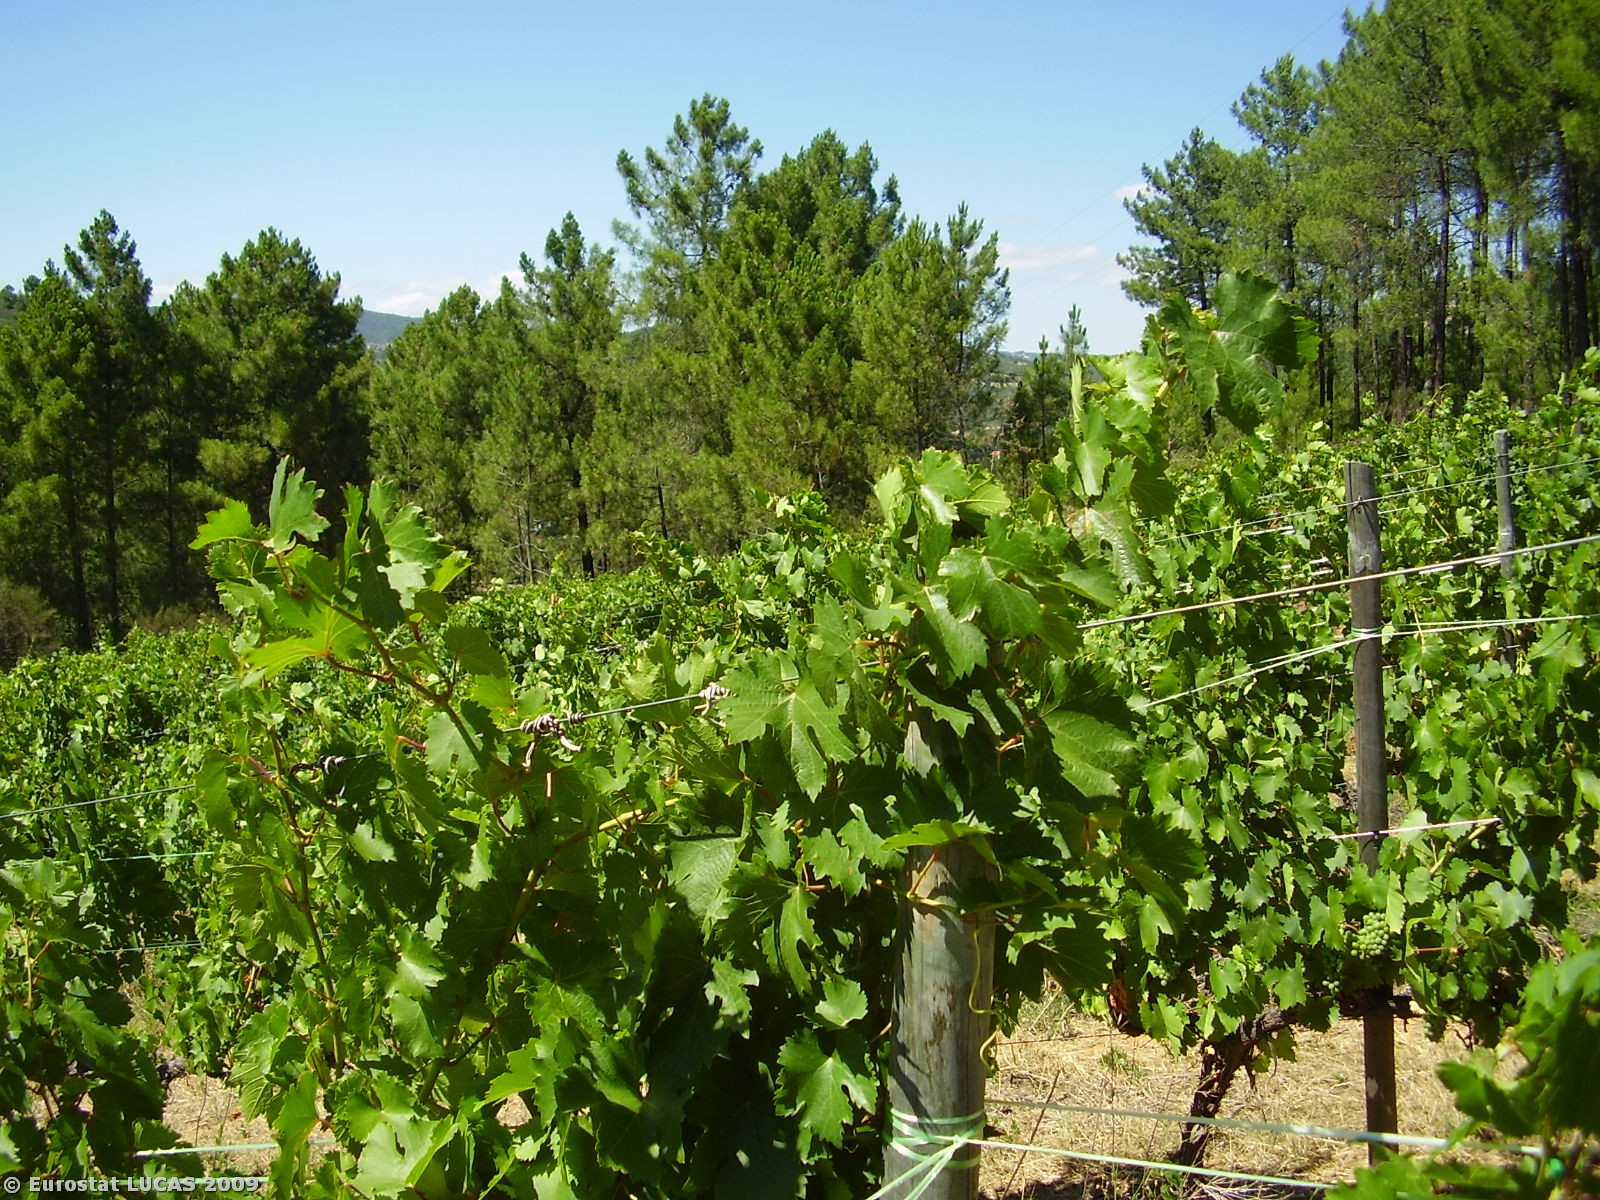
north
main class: Cropland
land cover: Vineyards
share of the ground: < 10 %
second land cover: Spontaneously vegetated surfaces
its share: > 75 %
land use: Agriculture (excluding fallow land and kitchen gardens)
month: July
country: PT
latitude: 41.6010
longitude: -7.3666
